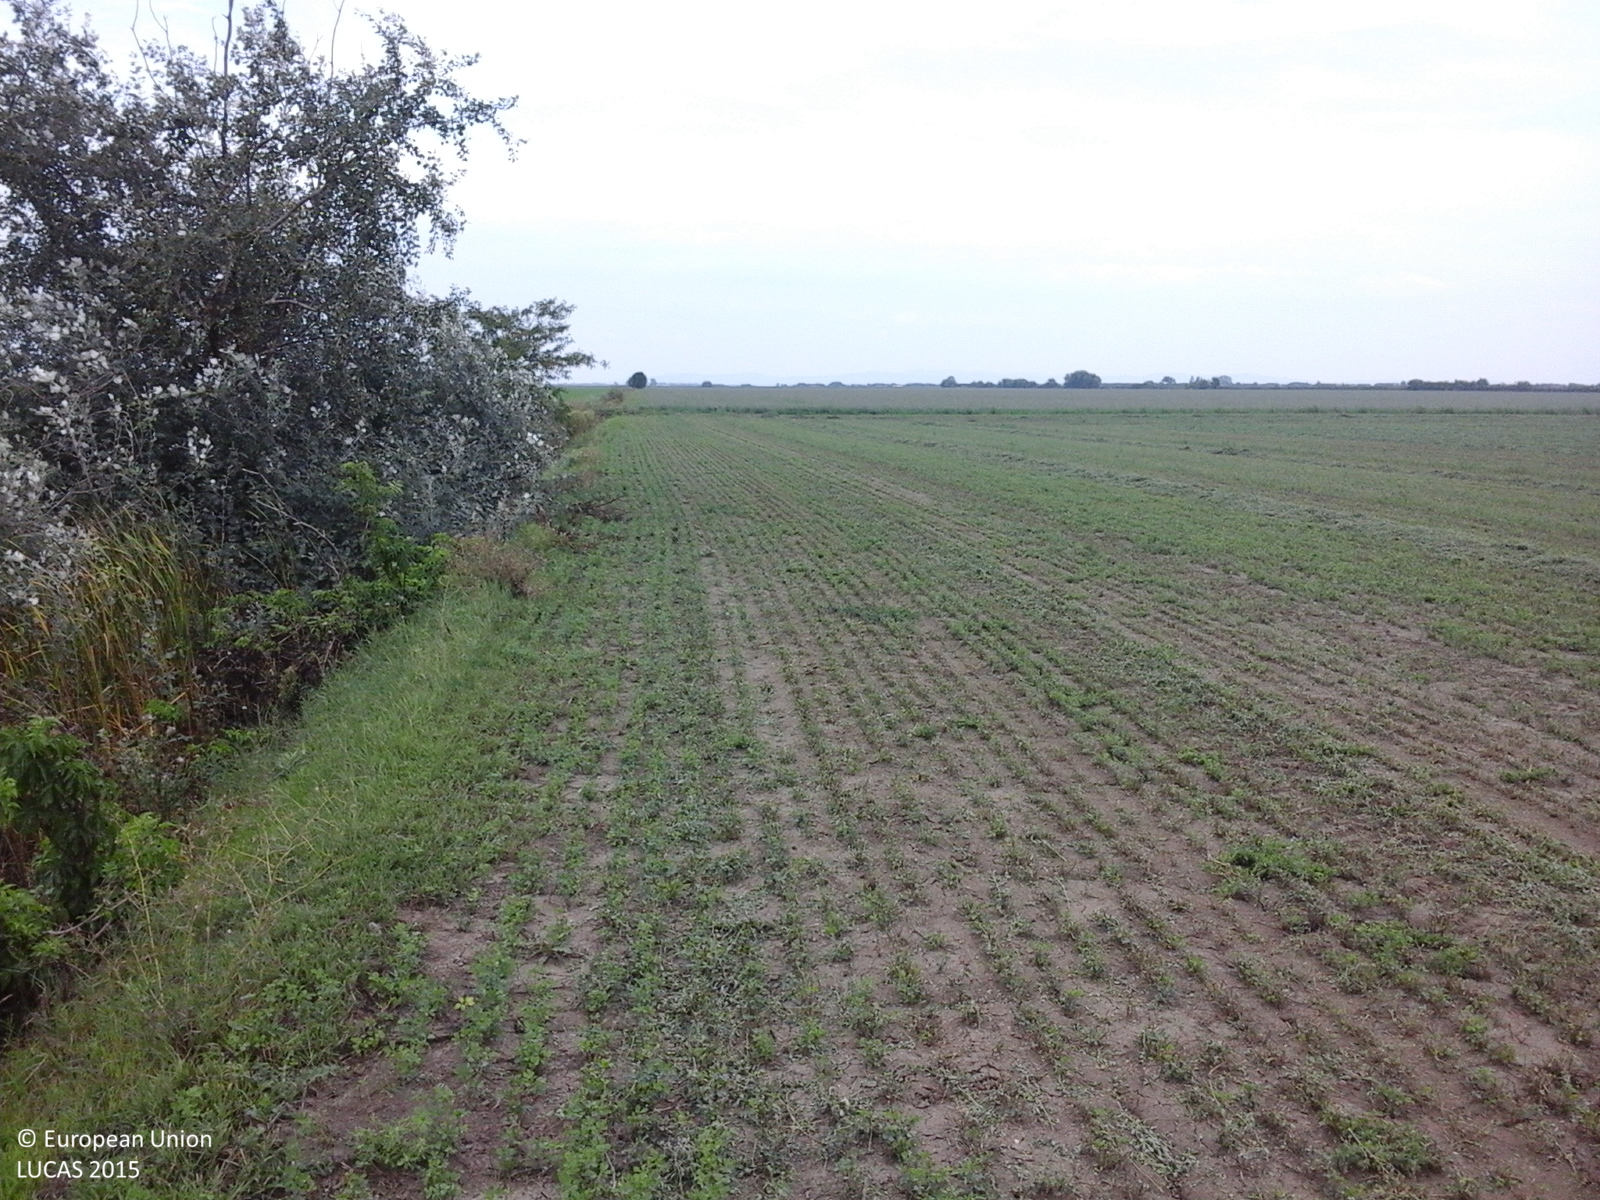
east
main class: Cropland
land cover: Lucerne
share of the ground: 50 - 75 %
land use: Agriculture (excluding fallow land and kitchen gardens)
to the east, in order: Lucerne; Tracks; Lucerne
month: August
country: RO
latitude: 46.2667
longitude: 21.2307
